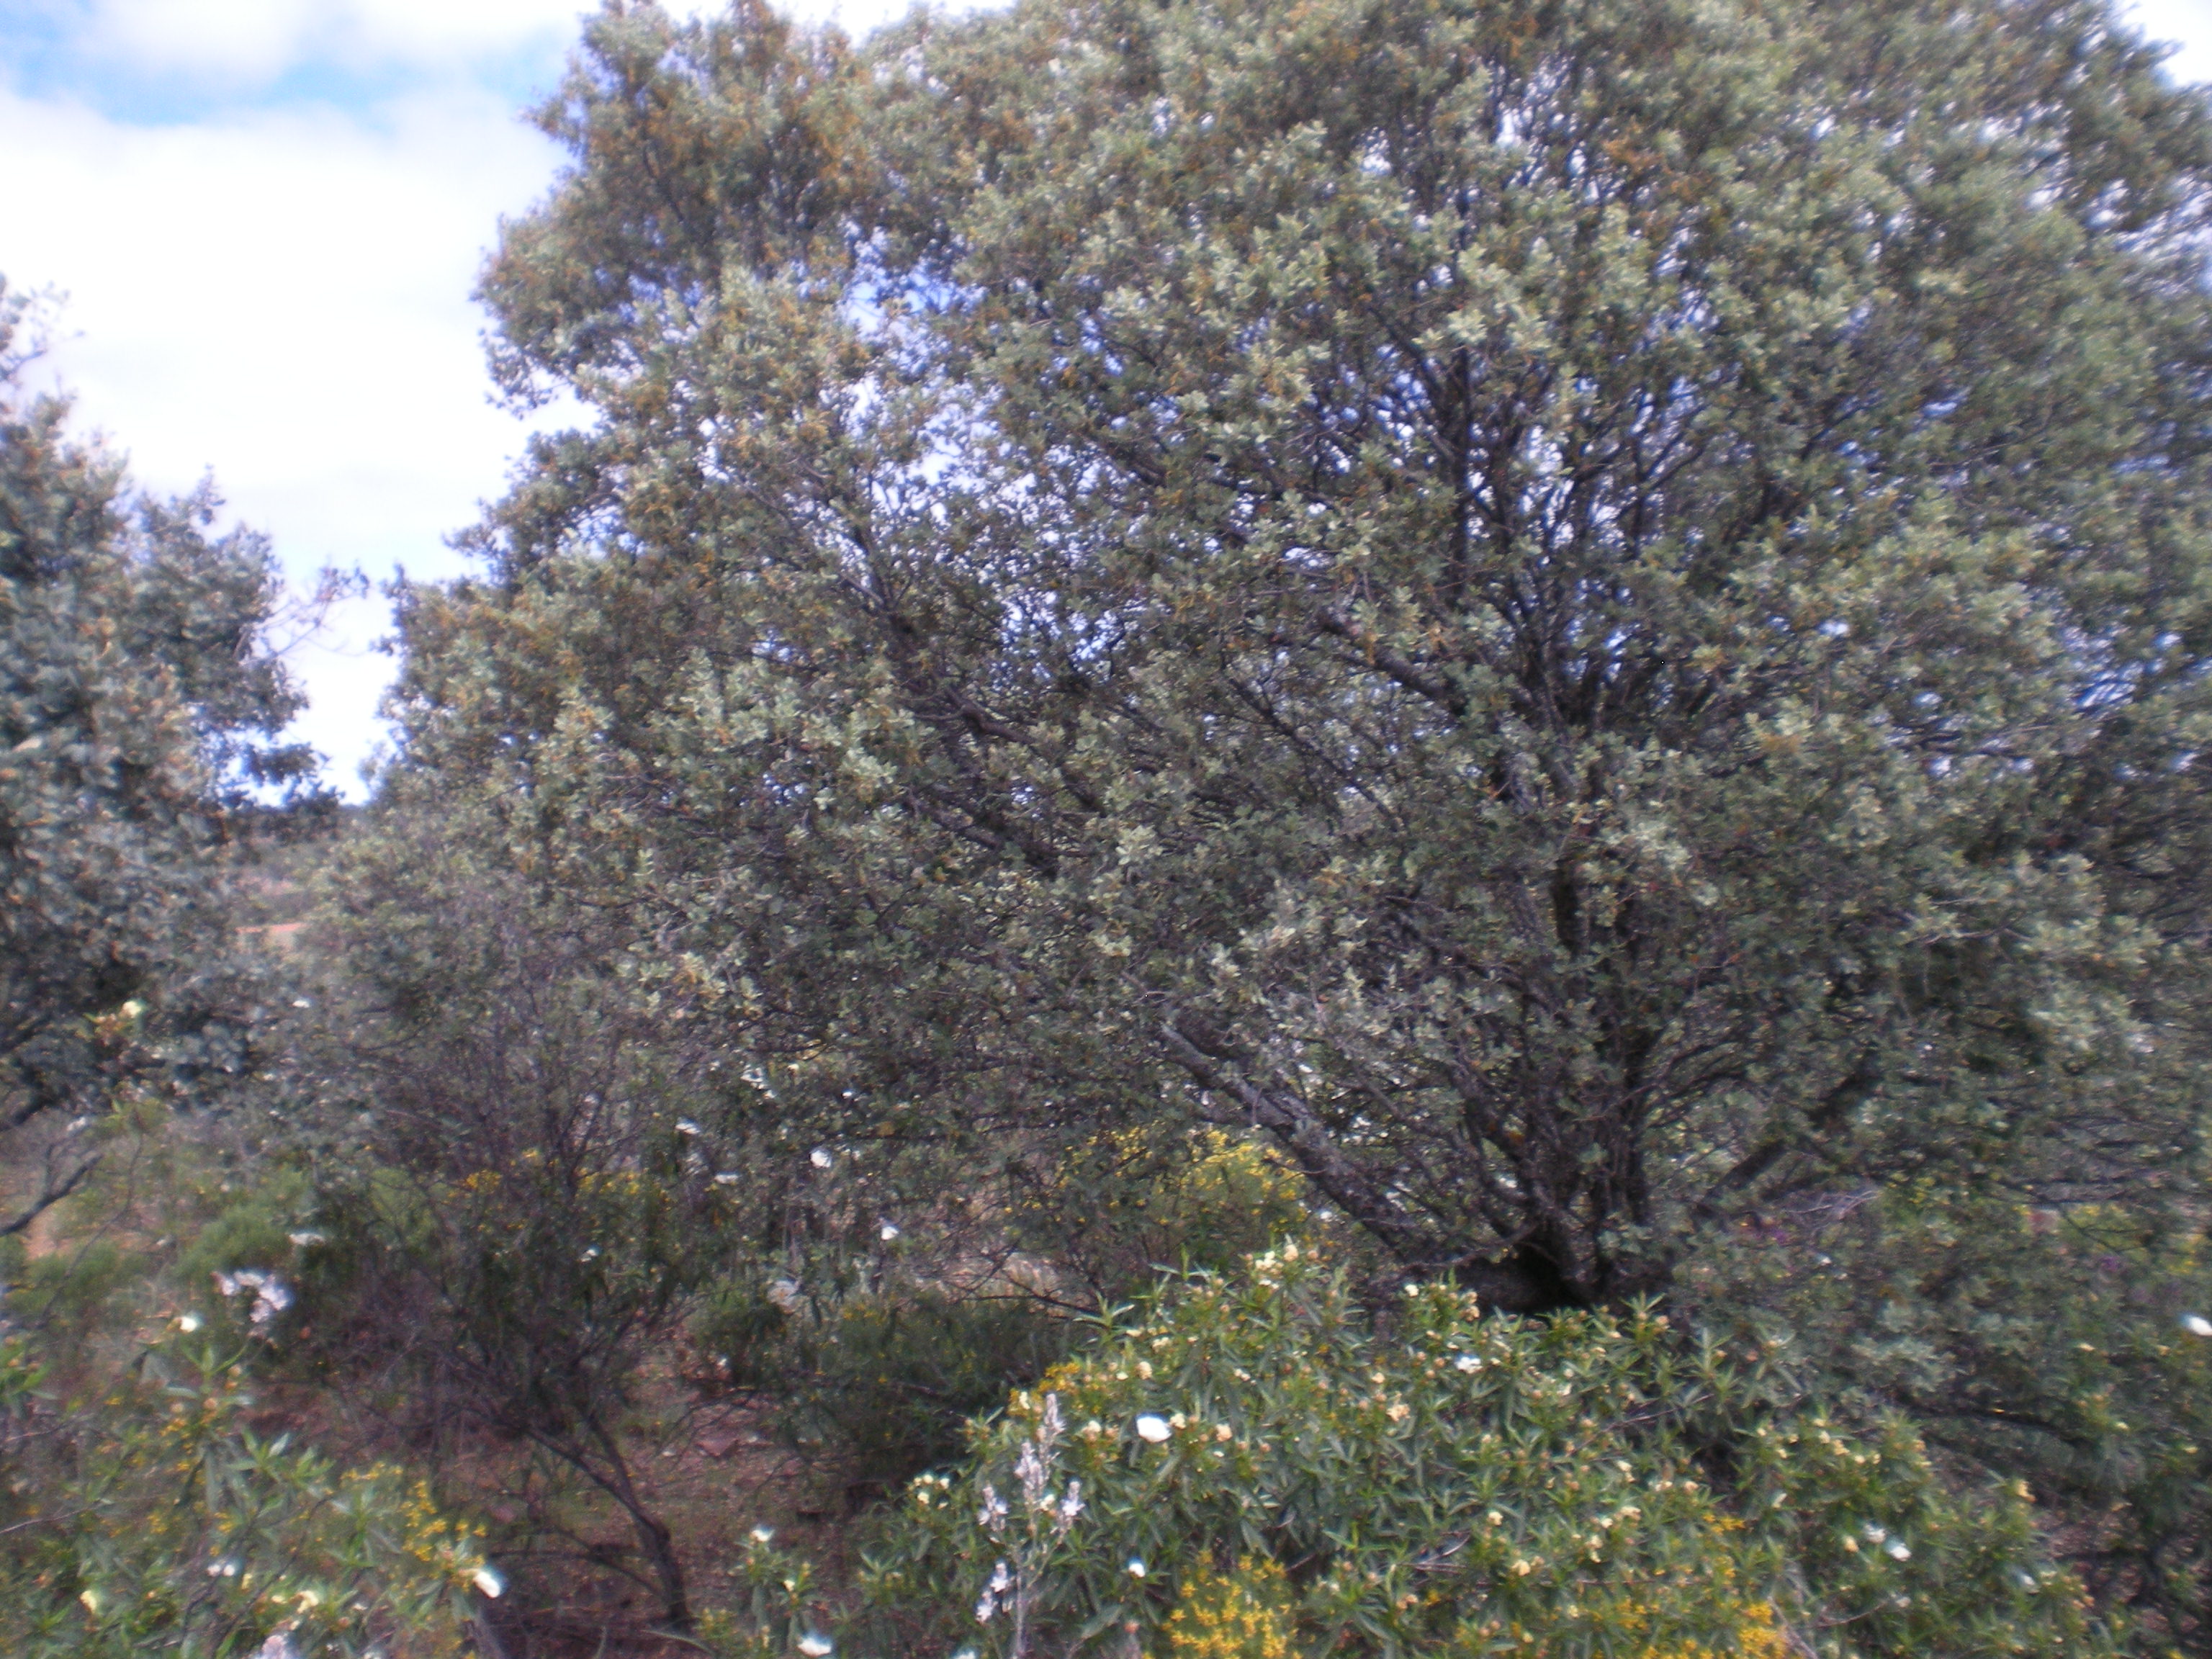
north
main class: Grassland
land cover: Spontaneously vegetated surfaces
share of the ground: 25 - 50 %
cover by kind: unconsolidated bare surface 75 %, herbaceous plants 25 %
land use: Fallow land
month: May
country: ES
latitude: 38.8344
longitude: -3.5031
